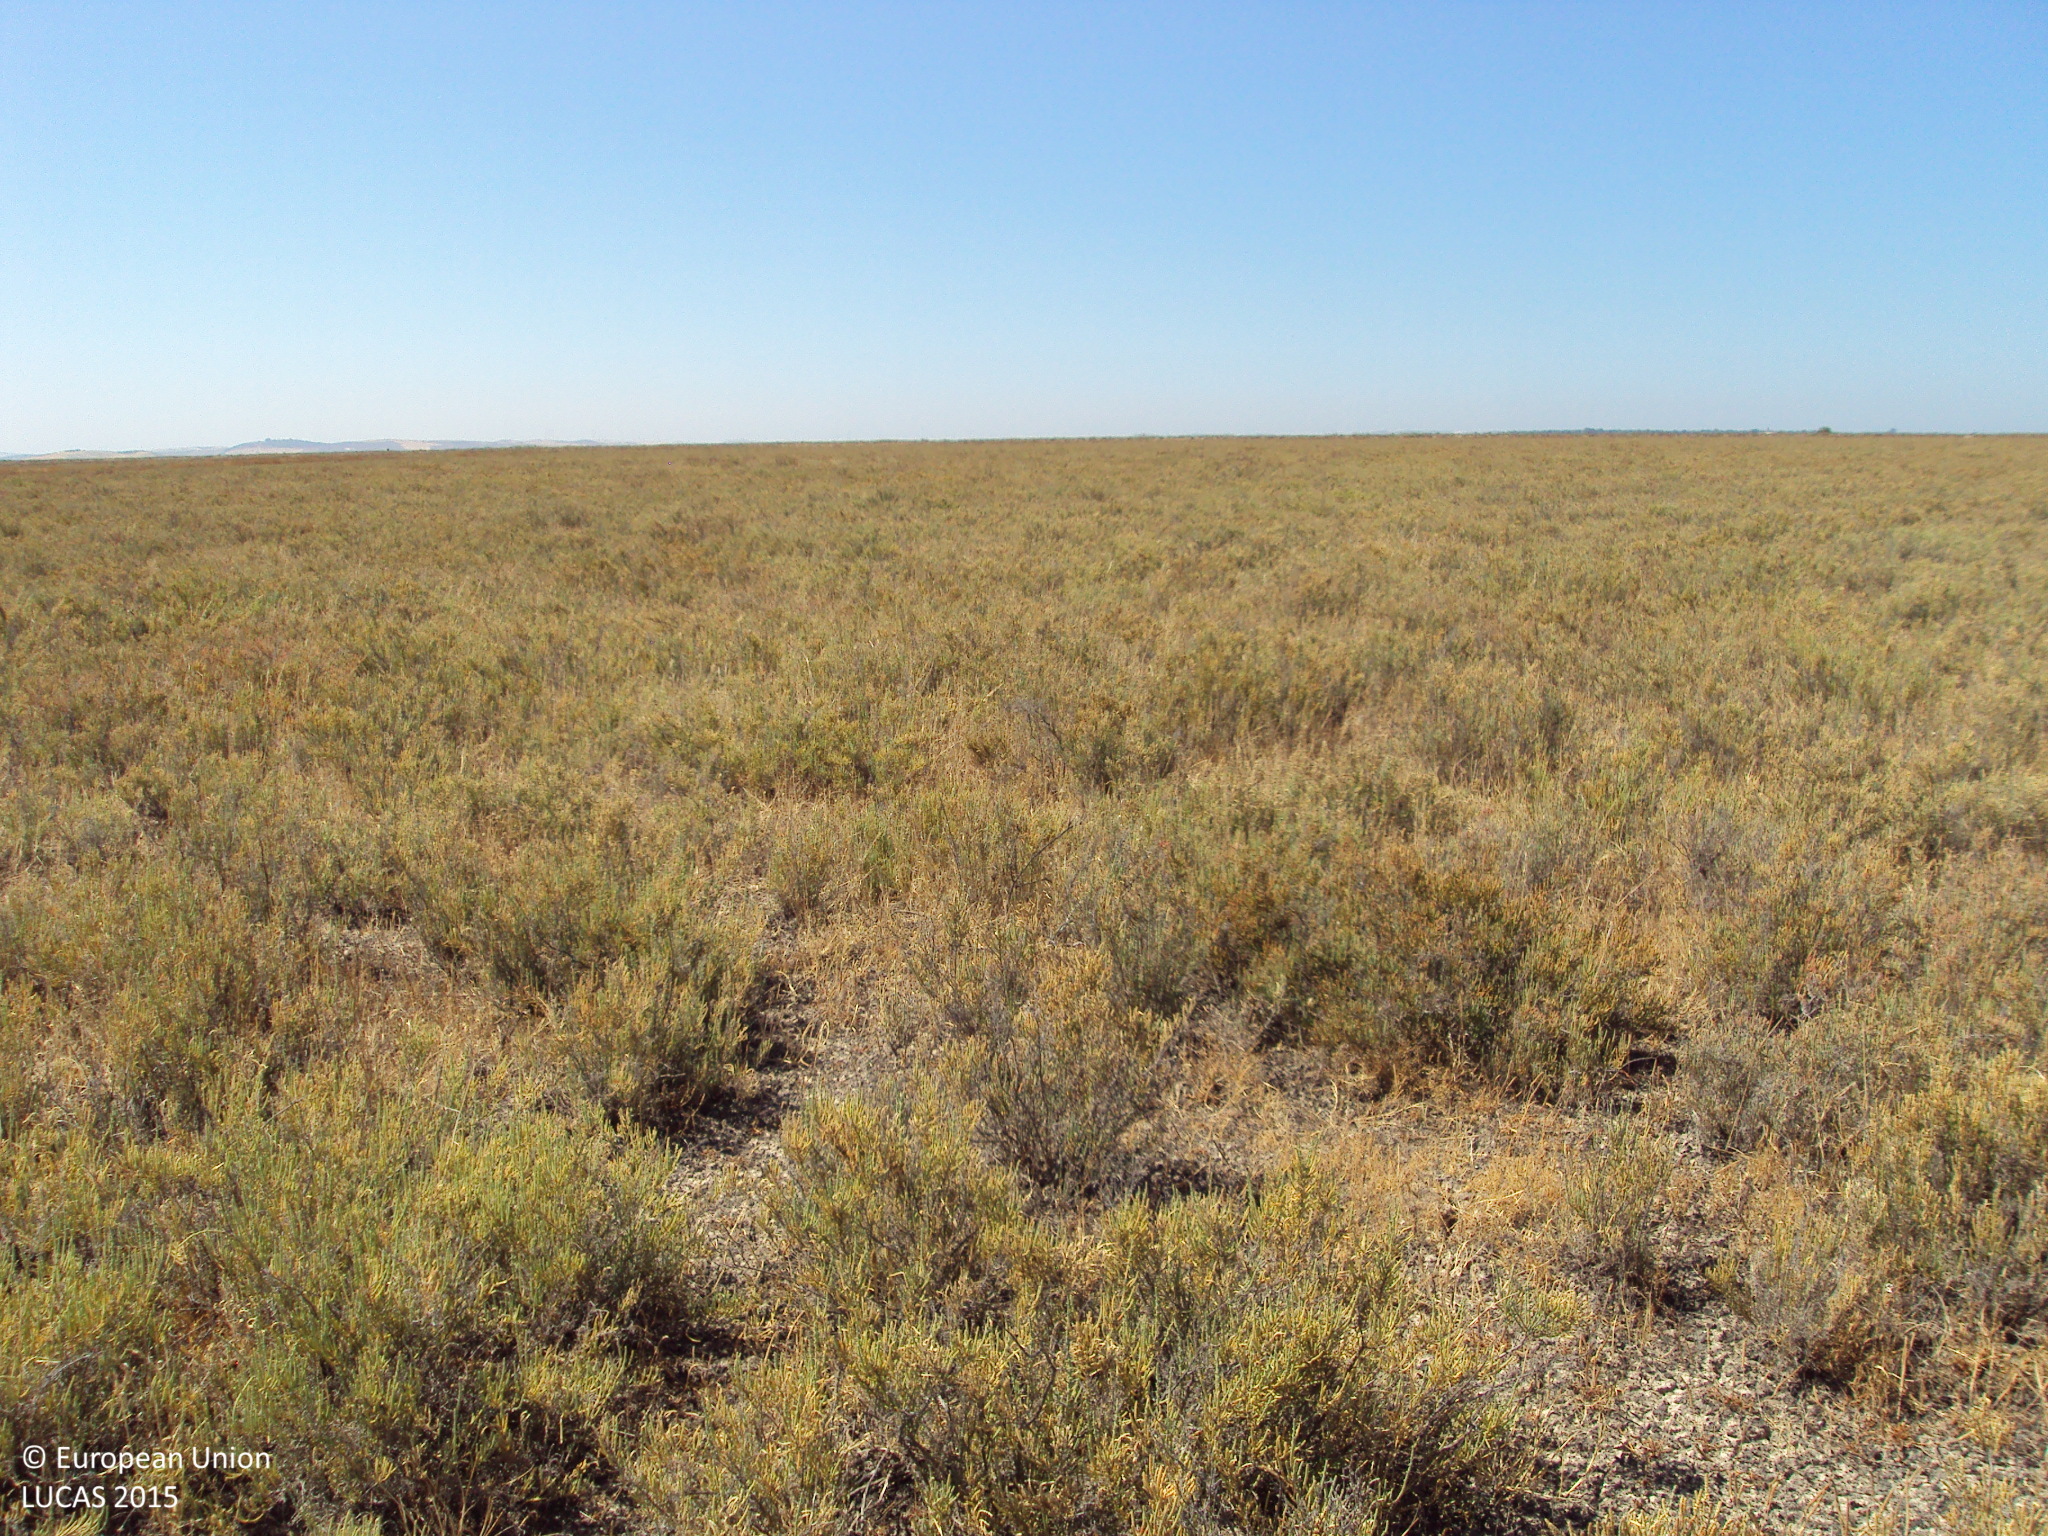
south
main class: Shrubland
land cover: Shrubland without tree cover
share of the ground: > 75 %
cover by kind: shrubs 70 %, consolidated bare surface 20 %, herbaceous plants 10 %
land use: Agriculture (excluding fallow land and kitchen gardens)
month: July
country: ES
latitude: 36.9278
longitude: -6.2638
